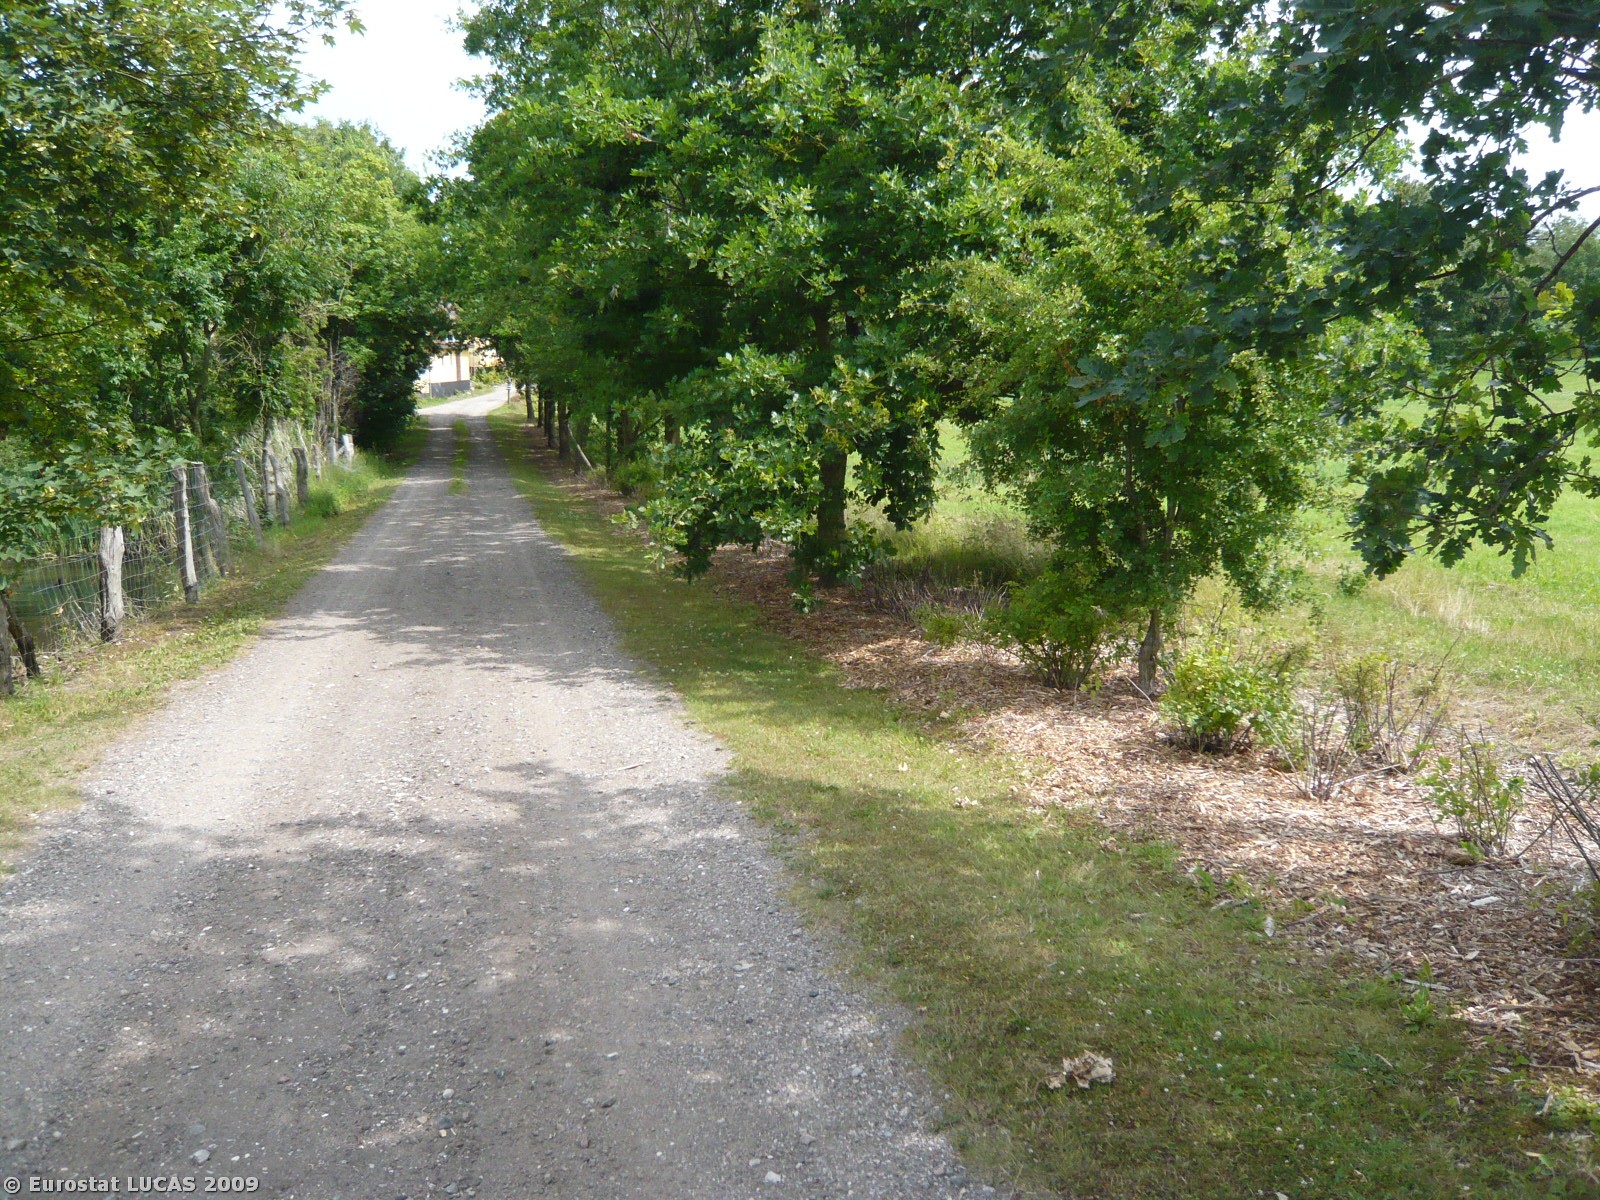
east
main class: Cropland
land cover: Common wheat
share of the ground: > 75 %
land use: Agriculture (excluding fallow land and kitchen gardens)
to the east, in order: Common wheat; Coniferous woodland; Grassland without tree/shrub cover; Broadleaved woodland; Paved roads, cycling and walking lanes; Fences; Artificial constructions in urban areas
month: July
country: DK
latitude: 55.5640
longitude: 11.7902
